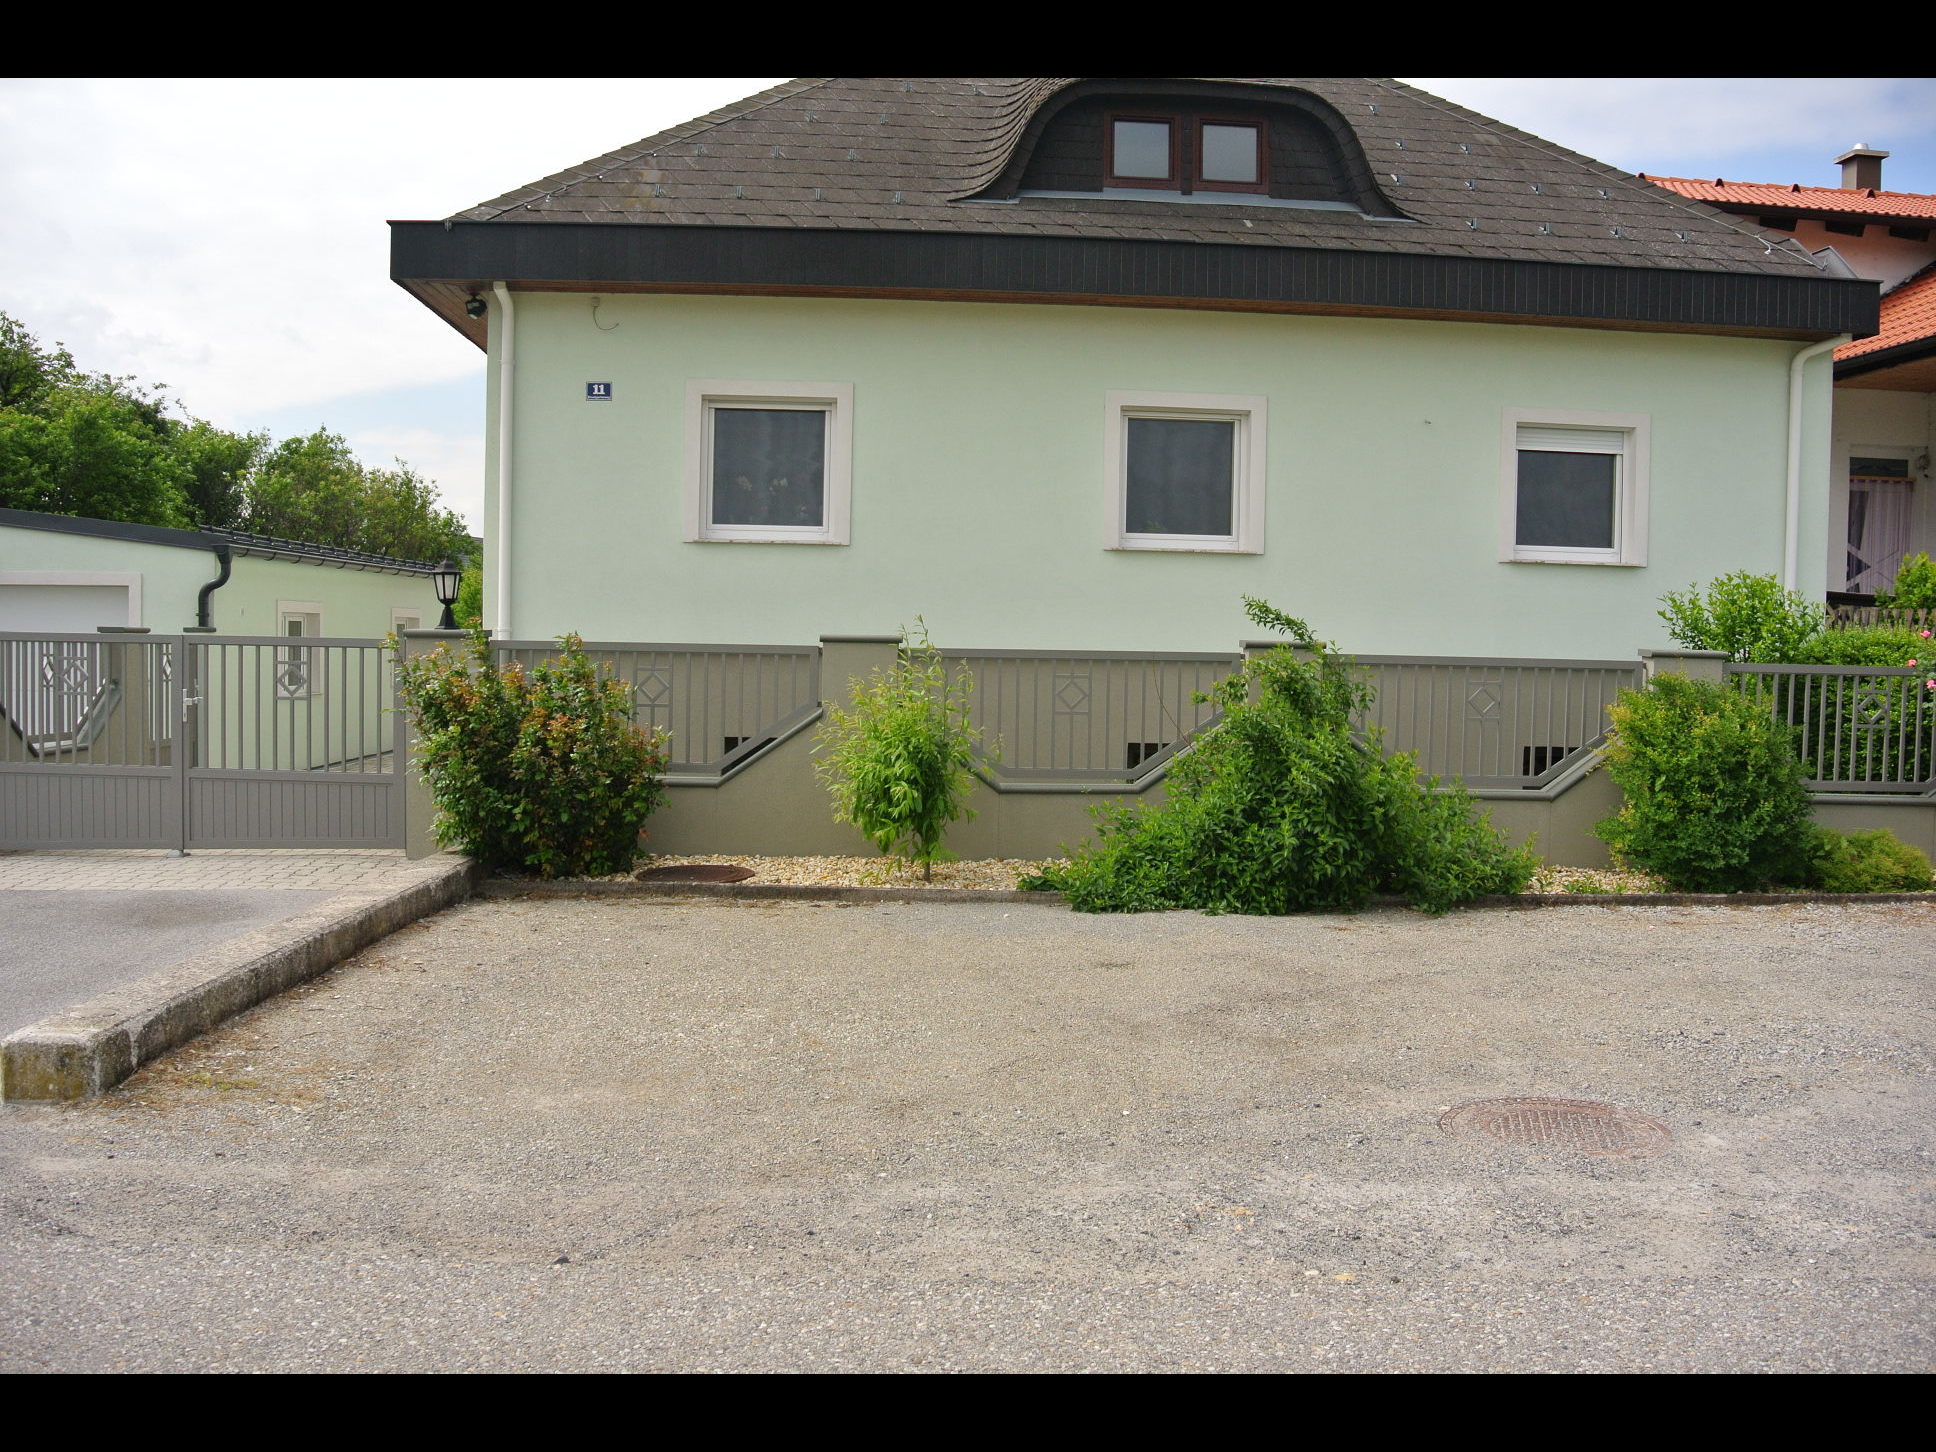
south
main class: Cropland
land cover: Other leguminous and mixtures for fodder
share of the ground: > 75 %
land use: Agriculture (excluding fallow land and kitchen gardens)
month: May
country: AT
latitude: 47.9450
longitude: 16.7402
